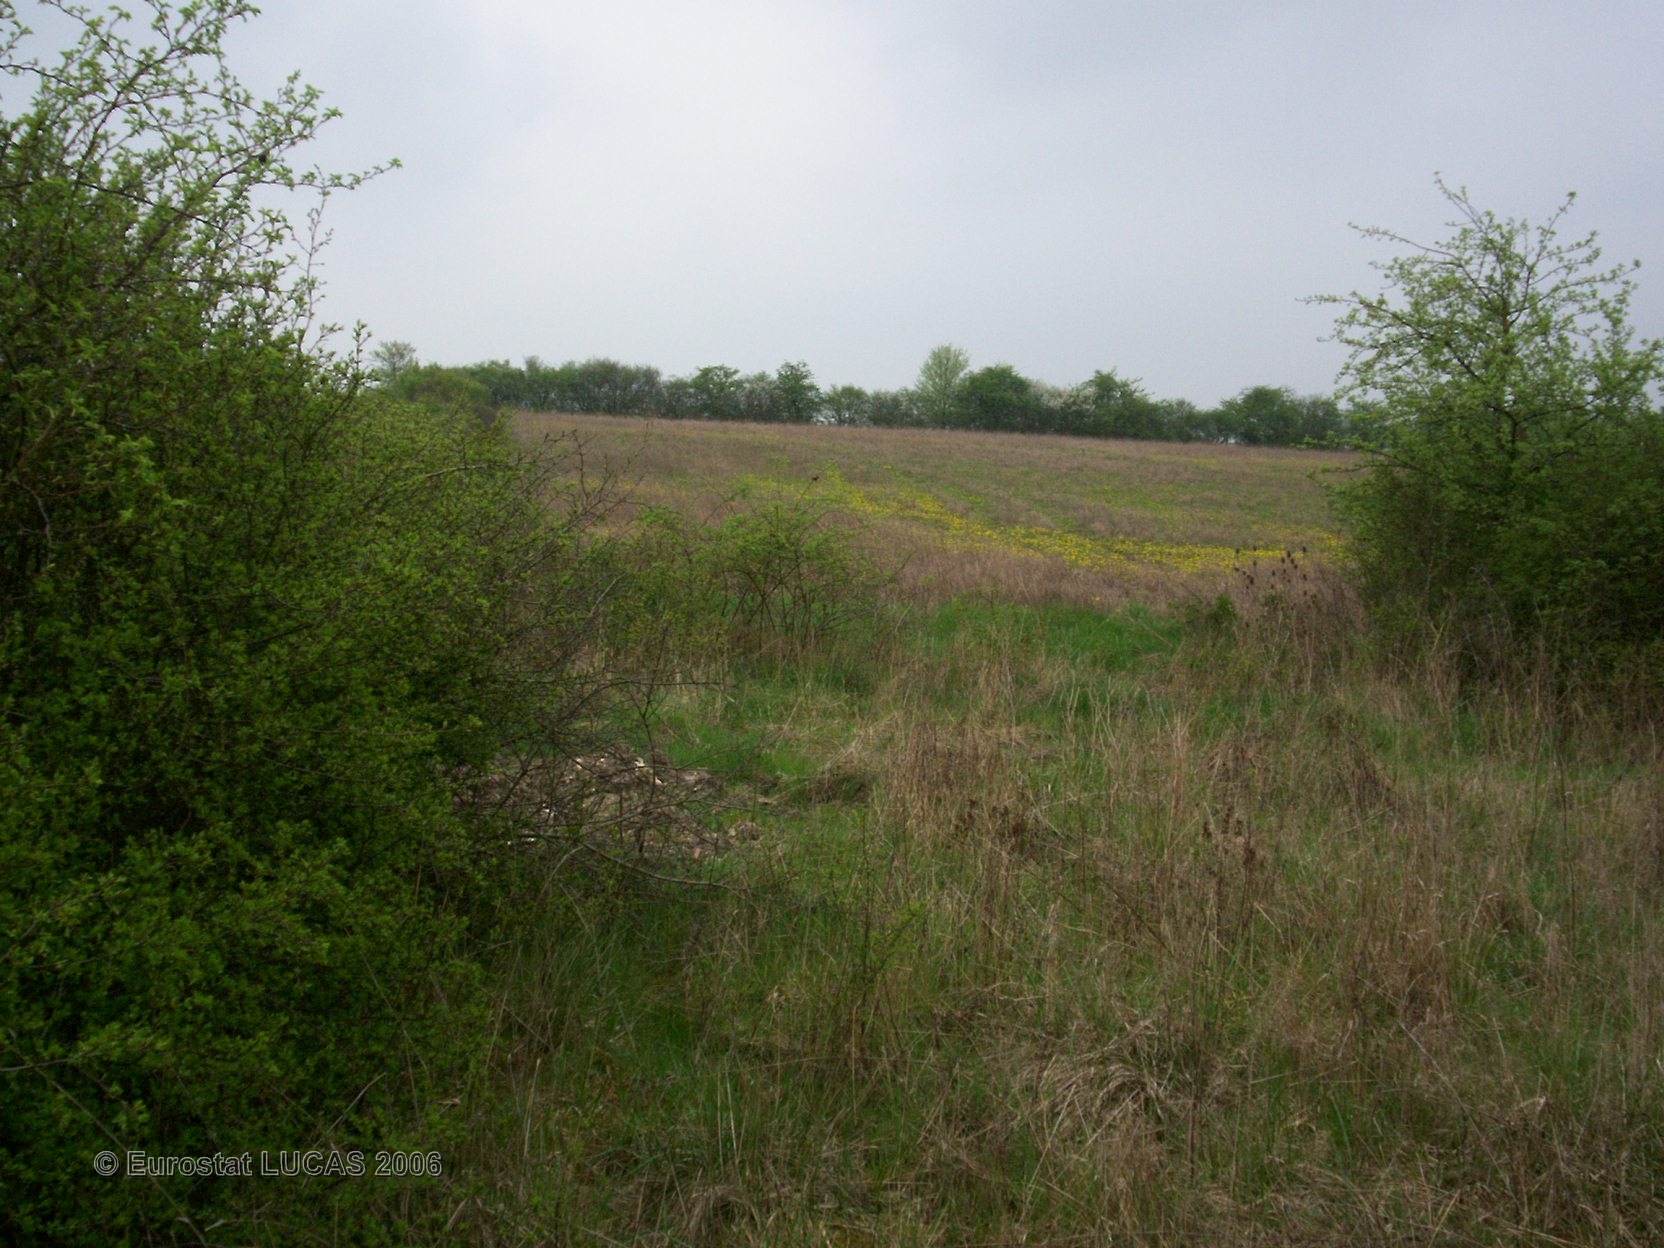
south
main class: Grassland
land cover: Grassland with sparse tree/shrub cover
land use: Agriculture (excluding fallow land and kitchen gardens)
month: April
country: FR
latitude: 48.8777
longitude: 6.7415
